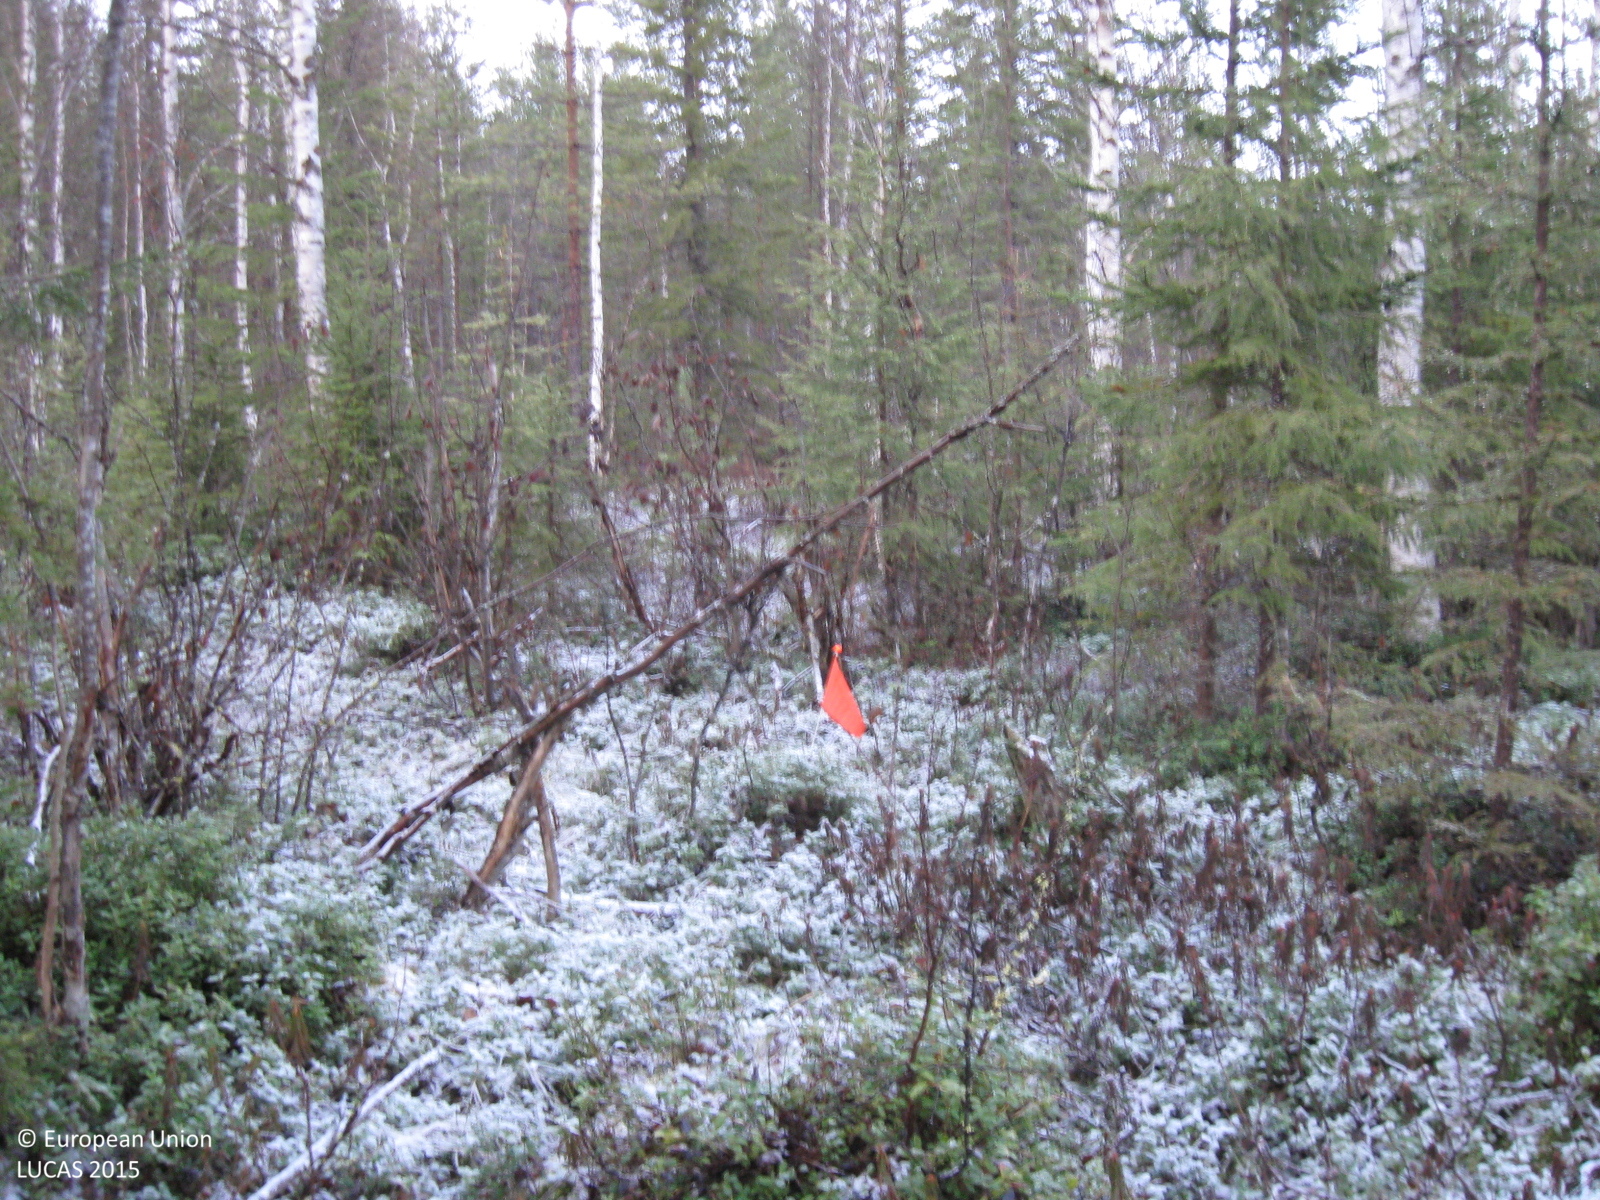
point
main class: Woodland
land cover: Spruce dominated mixed woodland
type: boreal forest
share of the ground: > 75 %
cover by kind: broadleaved forest trees 55 %, coniferous forest trees 20 %, shrubs 10 %, herbaceous plants 10 %, lichens and mosses 5 %
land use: Forestry
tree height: > 5 m
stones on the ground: < 10 %
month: October
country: SE
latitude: 66.2203
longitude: 20.8293
